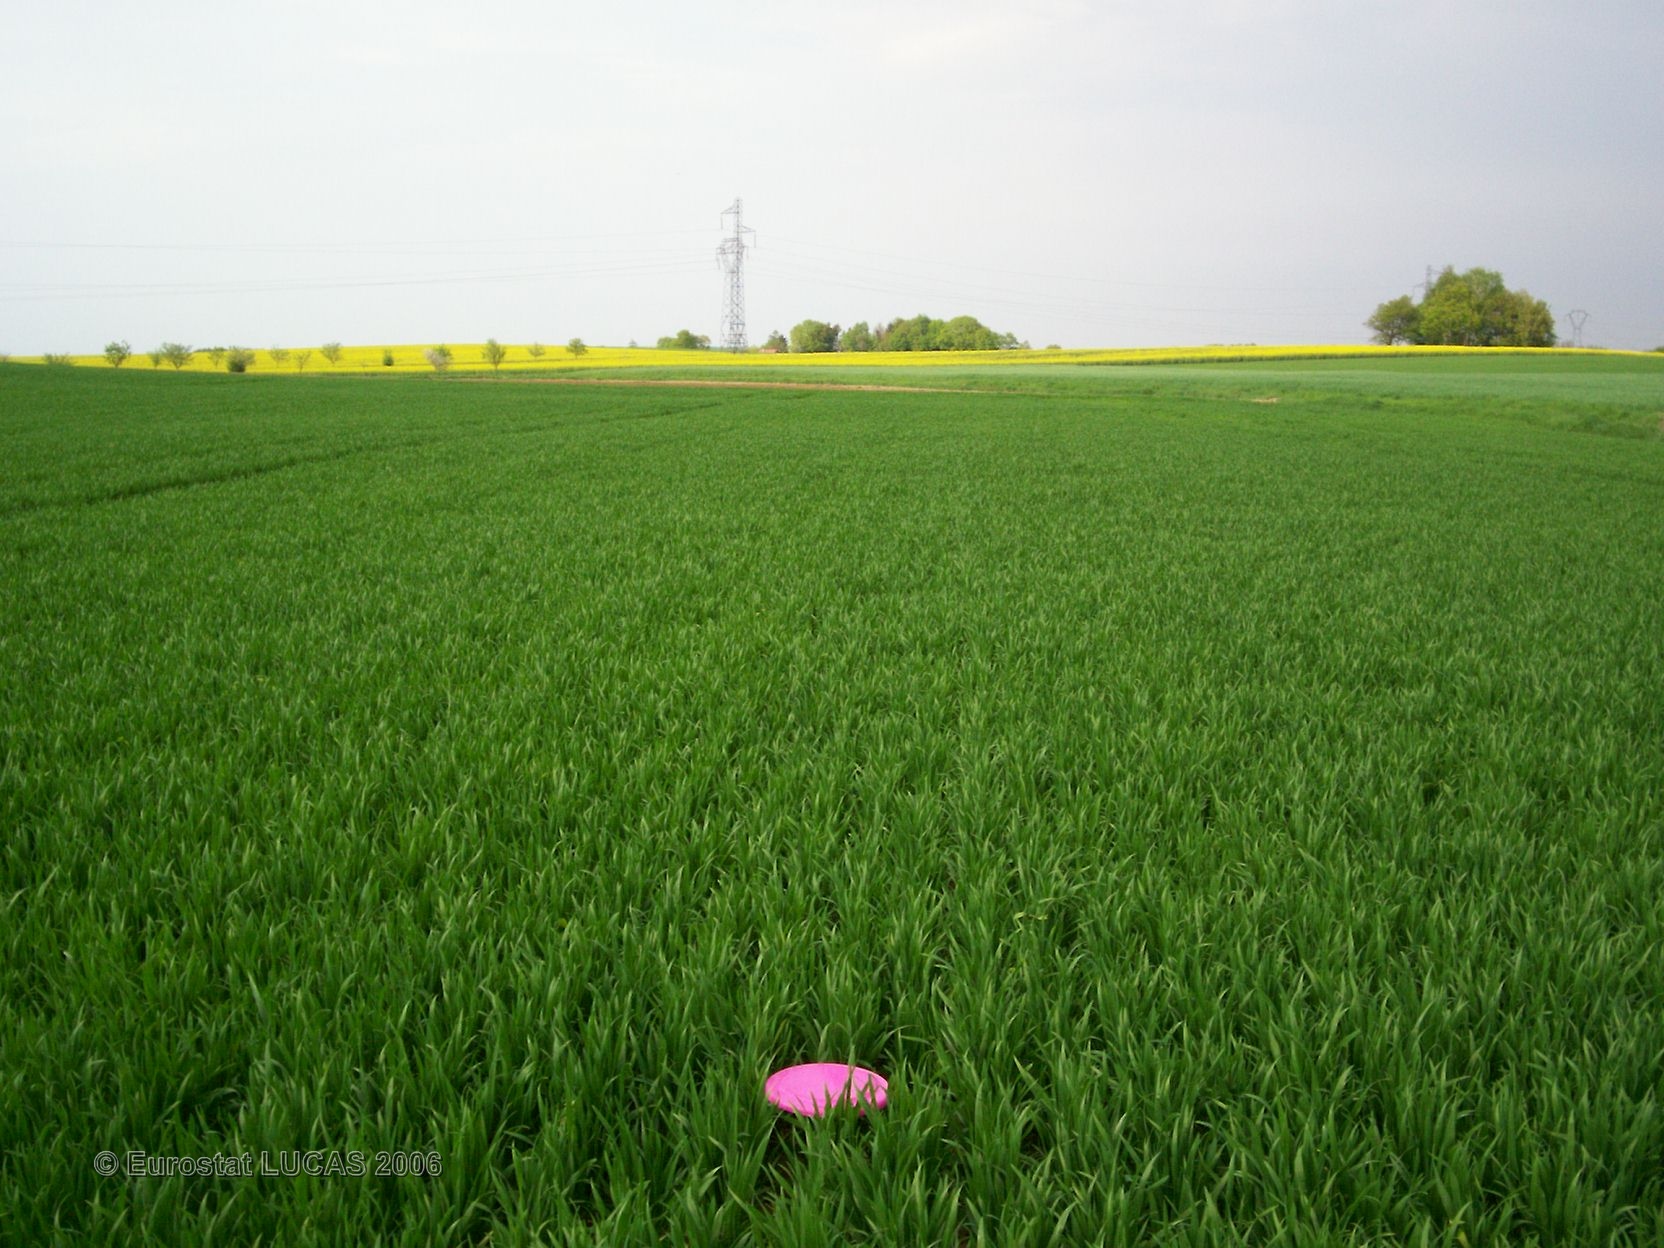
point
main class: Cropland
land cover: Common wheat
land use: Agriculture (excluding fallow land and kitchen gardens)
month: May
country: FR
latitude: 47.5736
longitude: 7.1169
